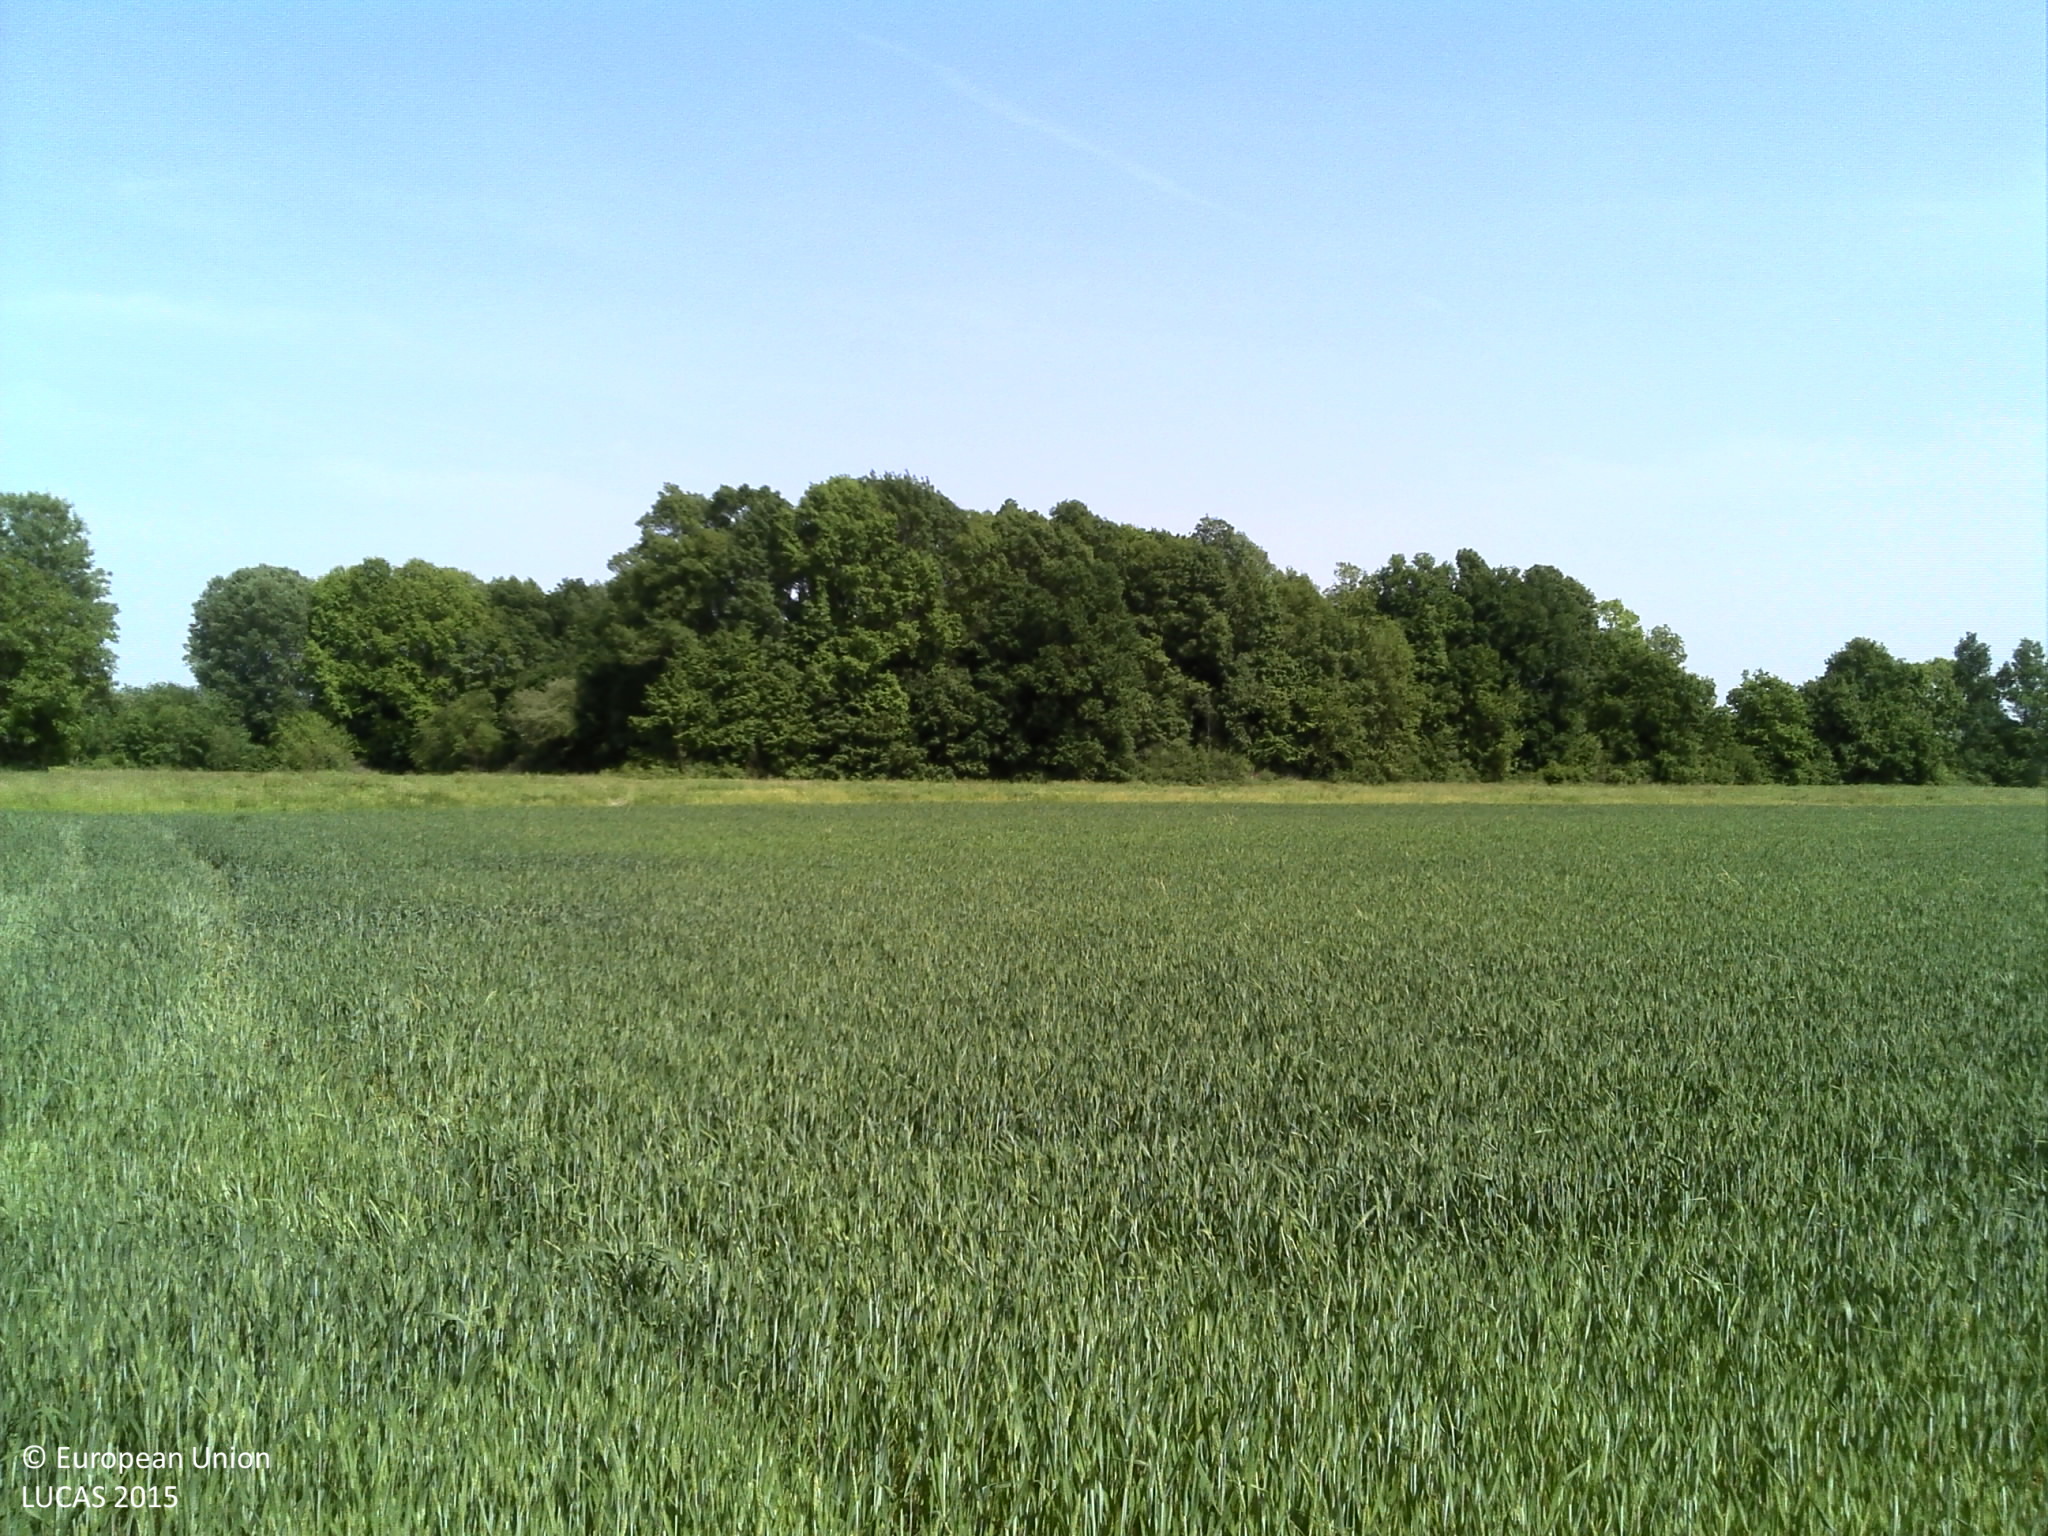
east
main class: Cropland
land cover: Common wheat
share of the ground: > 75 %
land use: Agriculture (excluding fallow land and kitchen gardens)
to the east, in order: Common wheat; Temporary grasslands; Other bare soil; Broadleaved woodland
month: May
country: HR
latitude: 45.1640
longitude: 18.4650
